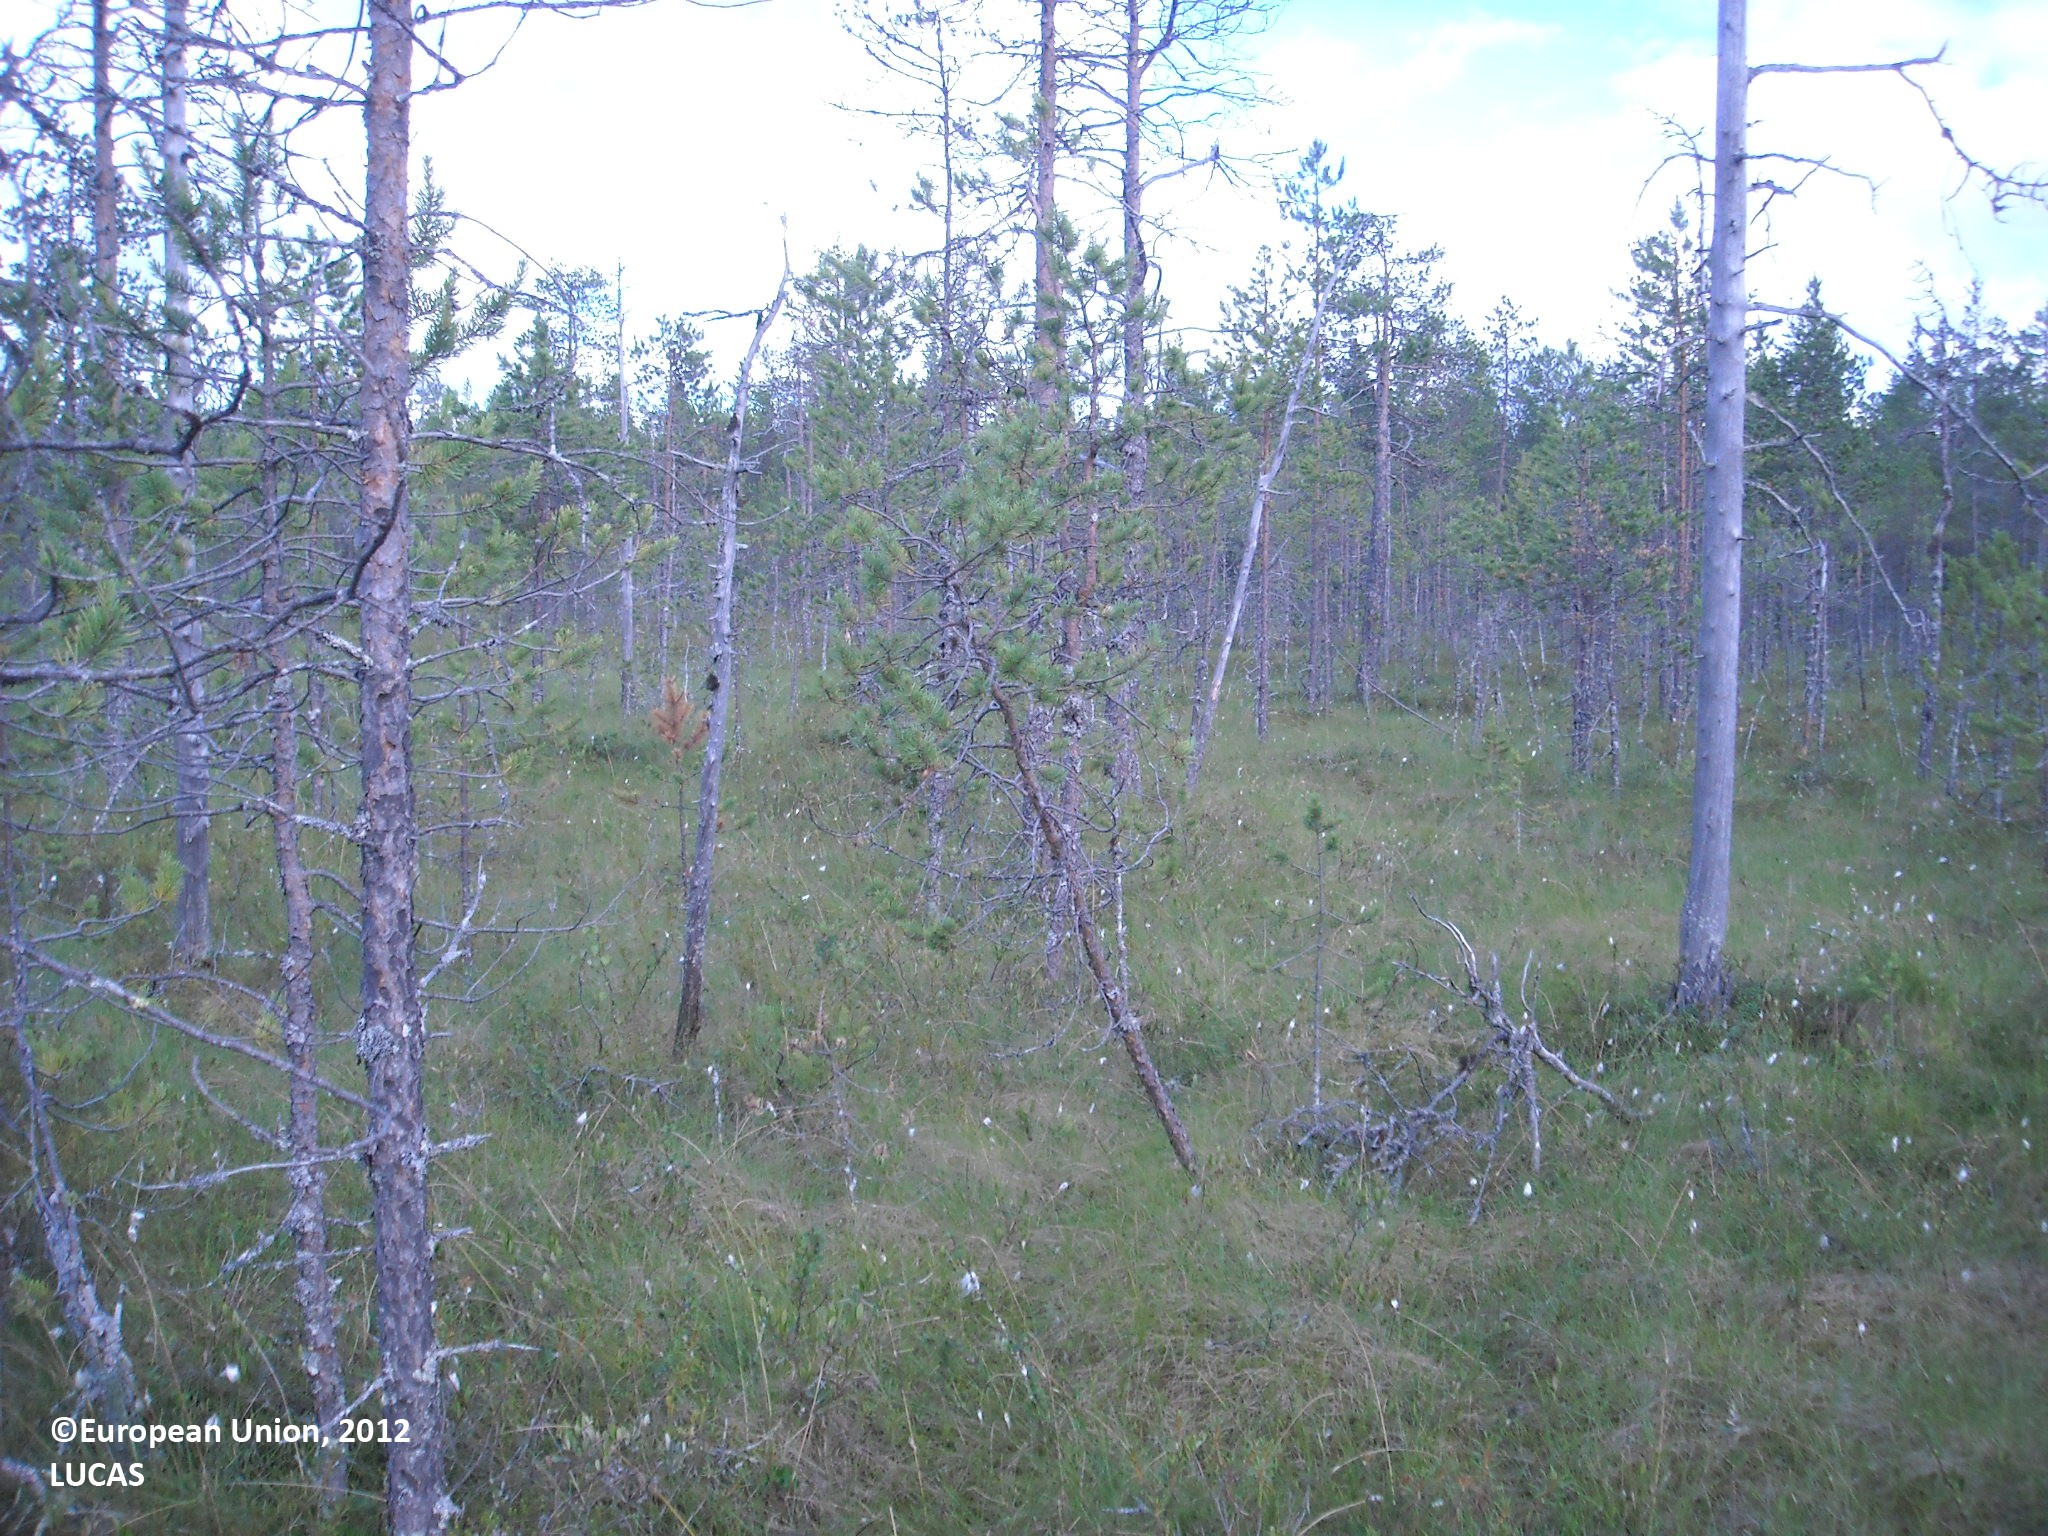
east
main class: Woodland
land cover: Pine dominated coniferous woodland
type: mire and swamp forests
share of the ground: 10 - 25 %
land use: Semi-natural and natural areas not in use
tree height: > 5 m
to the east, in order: Pine dominated coniferous woodland; Ditches and canals; Pine dominated coniferous woodland; Pine dominated mixed woodland; Ditches and canals; Pine dominated coniferous woodland
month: July
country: FI
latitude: 64.9092
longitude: 26.9231
